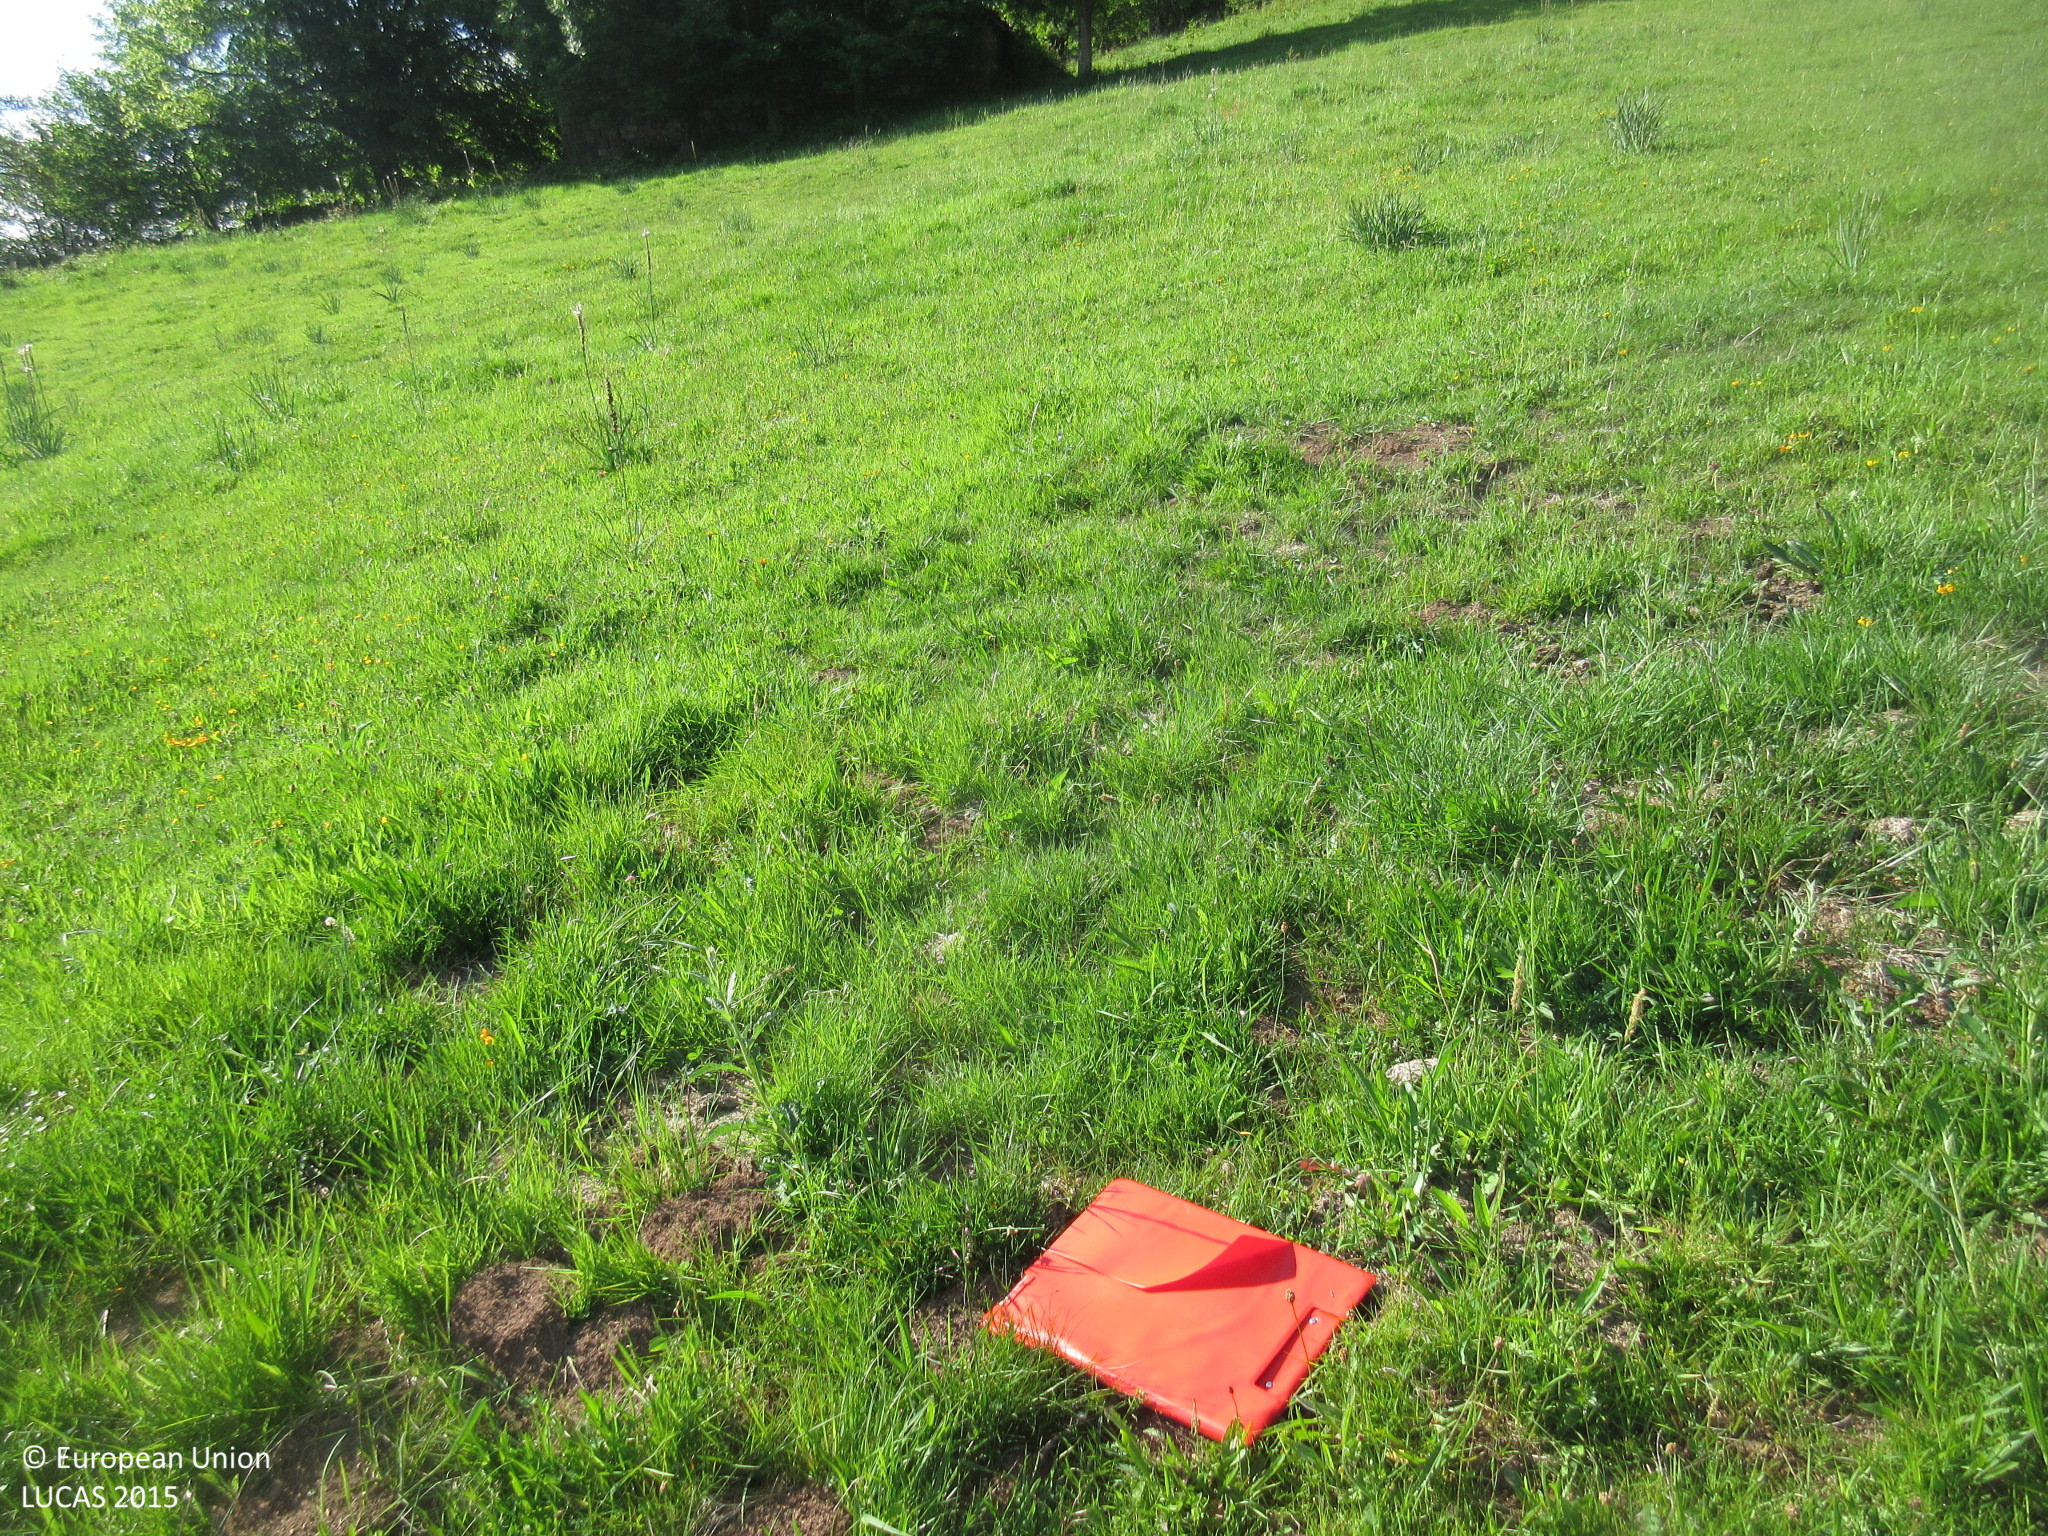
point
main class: Grassland
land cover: Grassland without tree/shrub cover
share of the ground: > 75 %
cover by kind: herbaceous plants 100 %
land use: Agriculture (excluding fallow land and kitchen gardens)
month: May
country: ES
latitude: 43.2269
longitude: -4.5512
